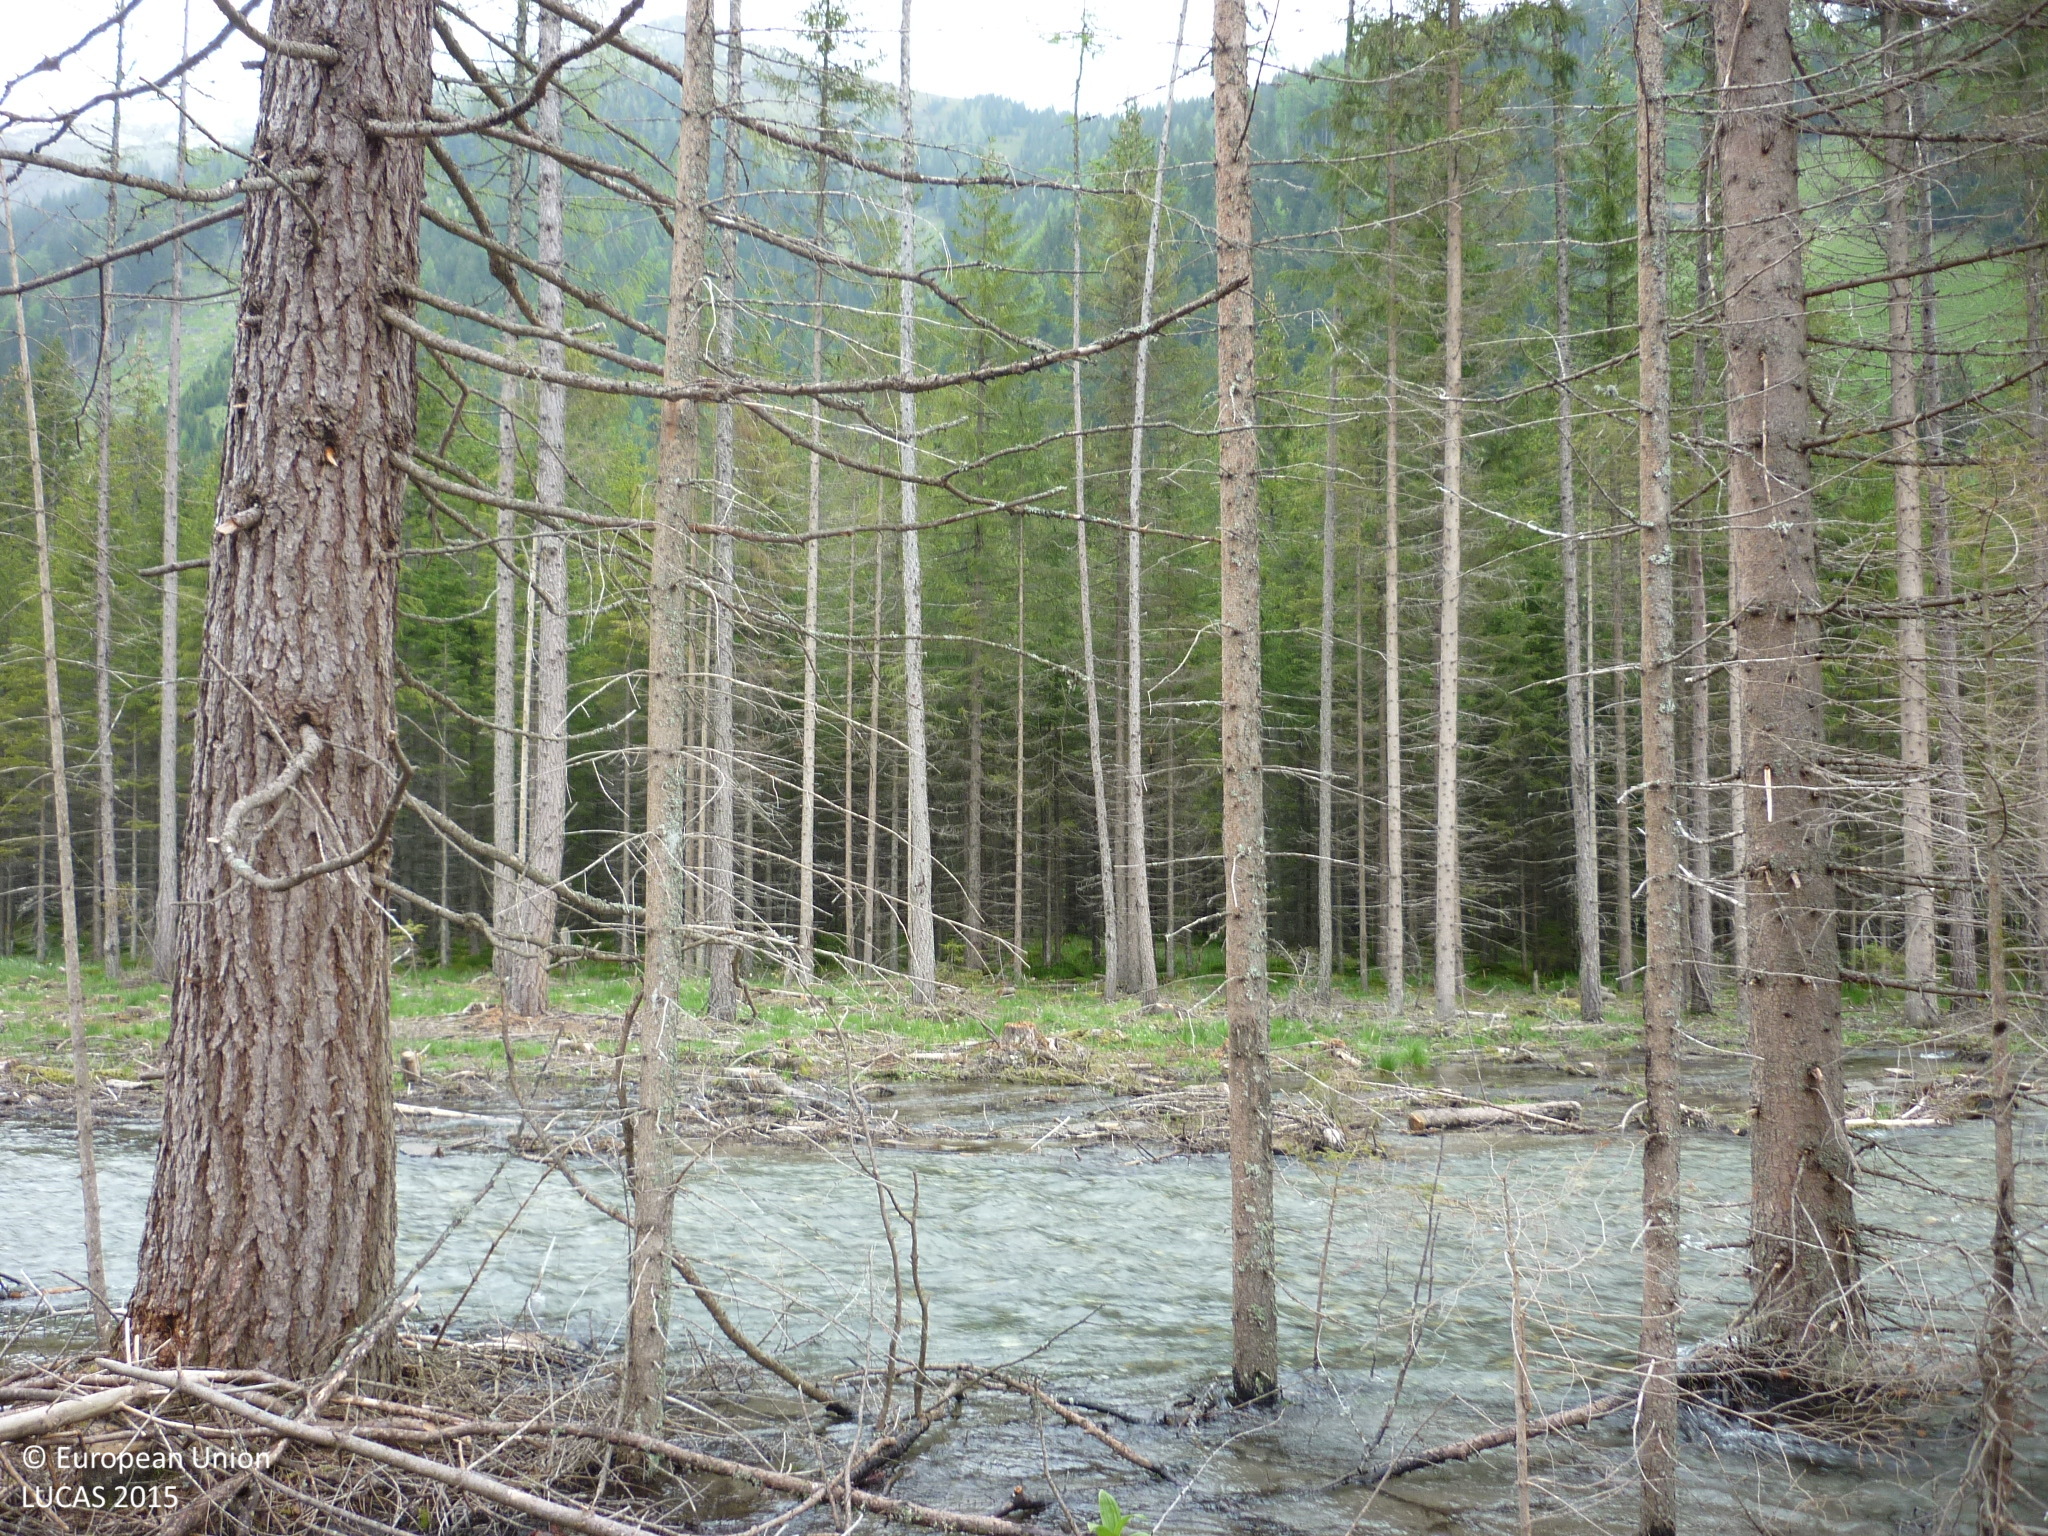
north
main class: Woodland
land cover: Spruce dominated coniferous woodland
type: alpine coniferous forest
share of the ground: 50 - 75 %
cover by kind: coniferous forest trees 60 %, consolidated bare surface 10 %, unconsolidated bare surface 10 %
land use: Forestry
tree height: > 5 m
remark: Temporary flooded
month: May
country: AT
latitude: 47.4132
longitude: 14.4389
